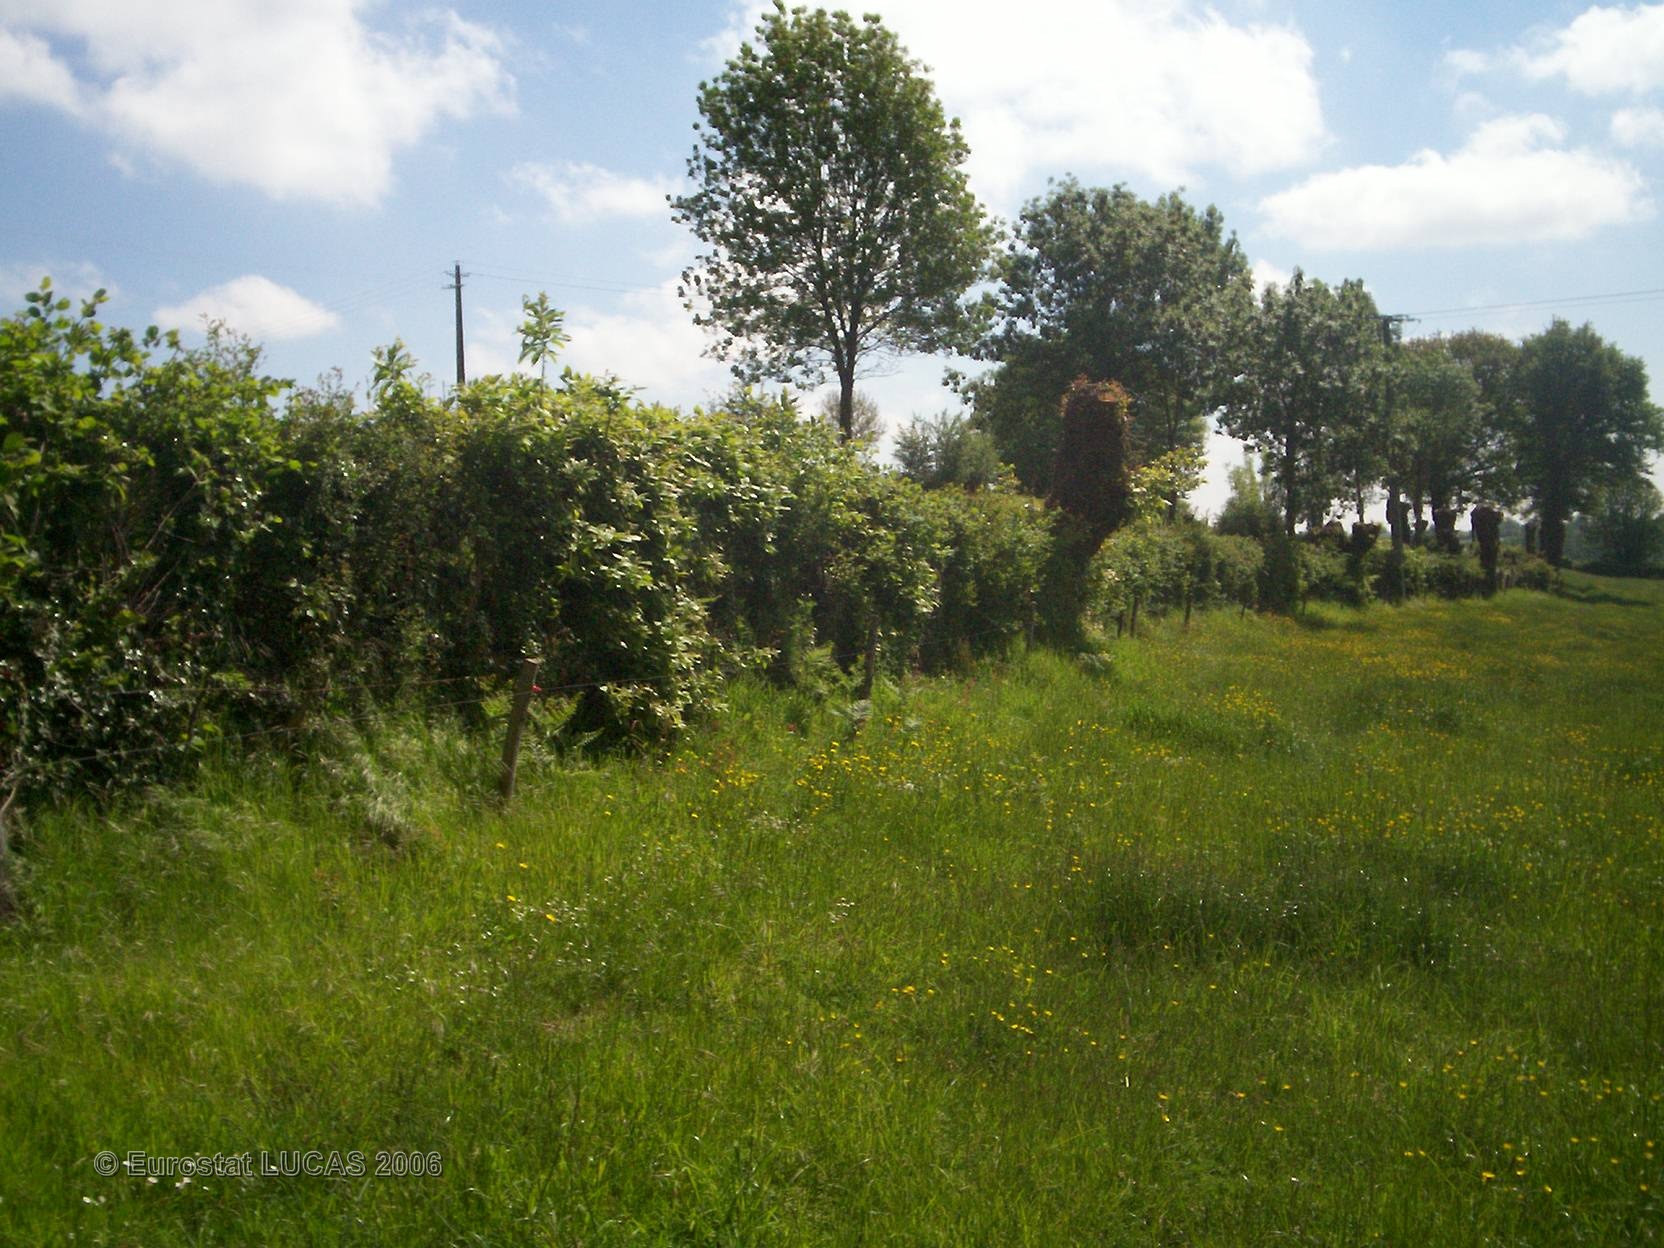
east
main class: Grassland
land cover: Grassland without tree/shrub cover
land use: Agriculture (excluding fallow land and kitchen gardens)
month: May
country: FR
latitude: 46.8332
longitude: -0.8479
